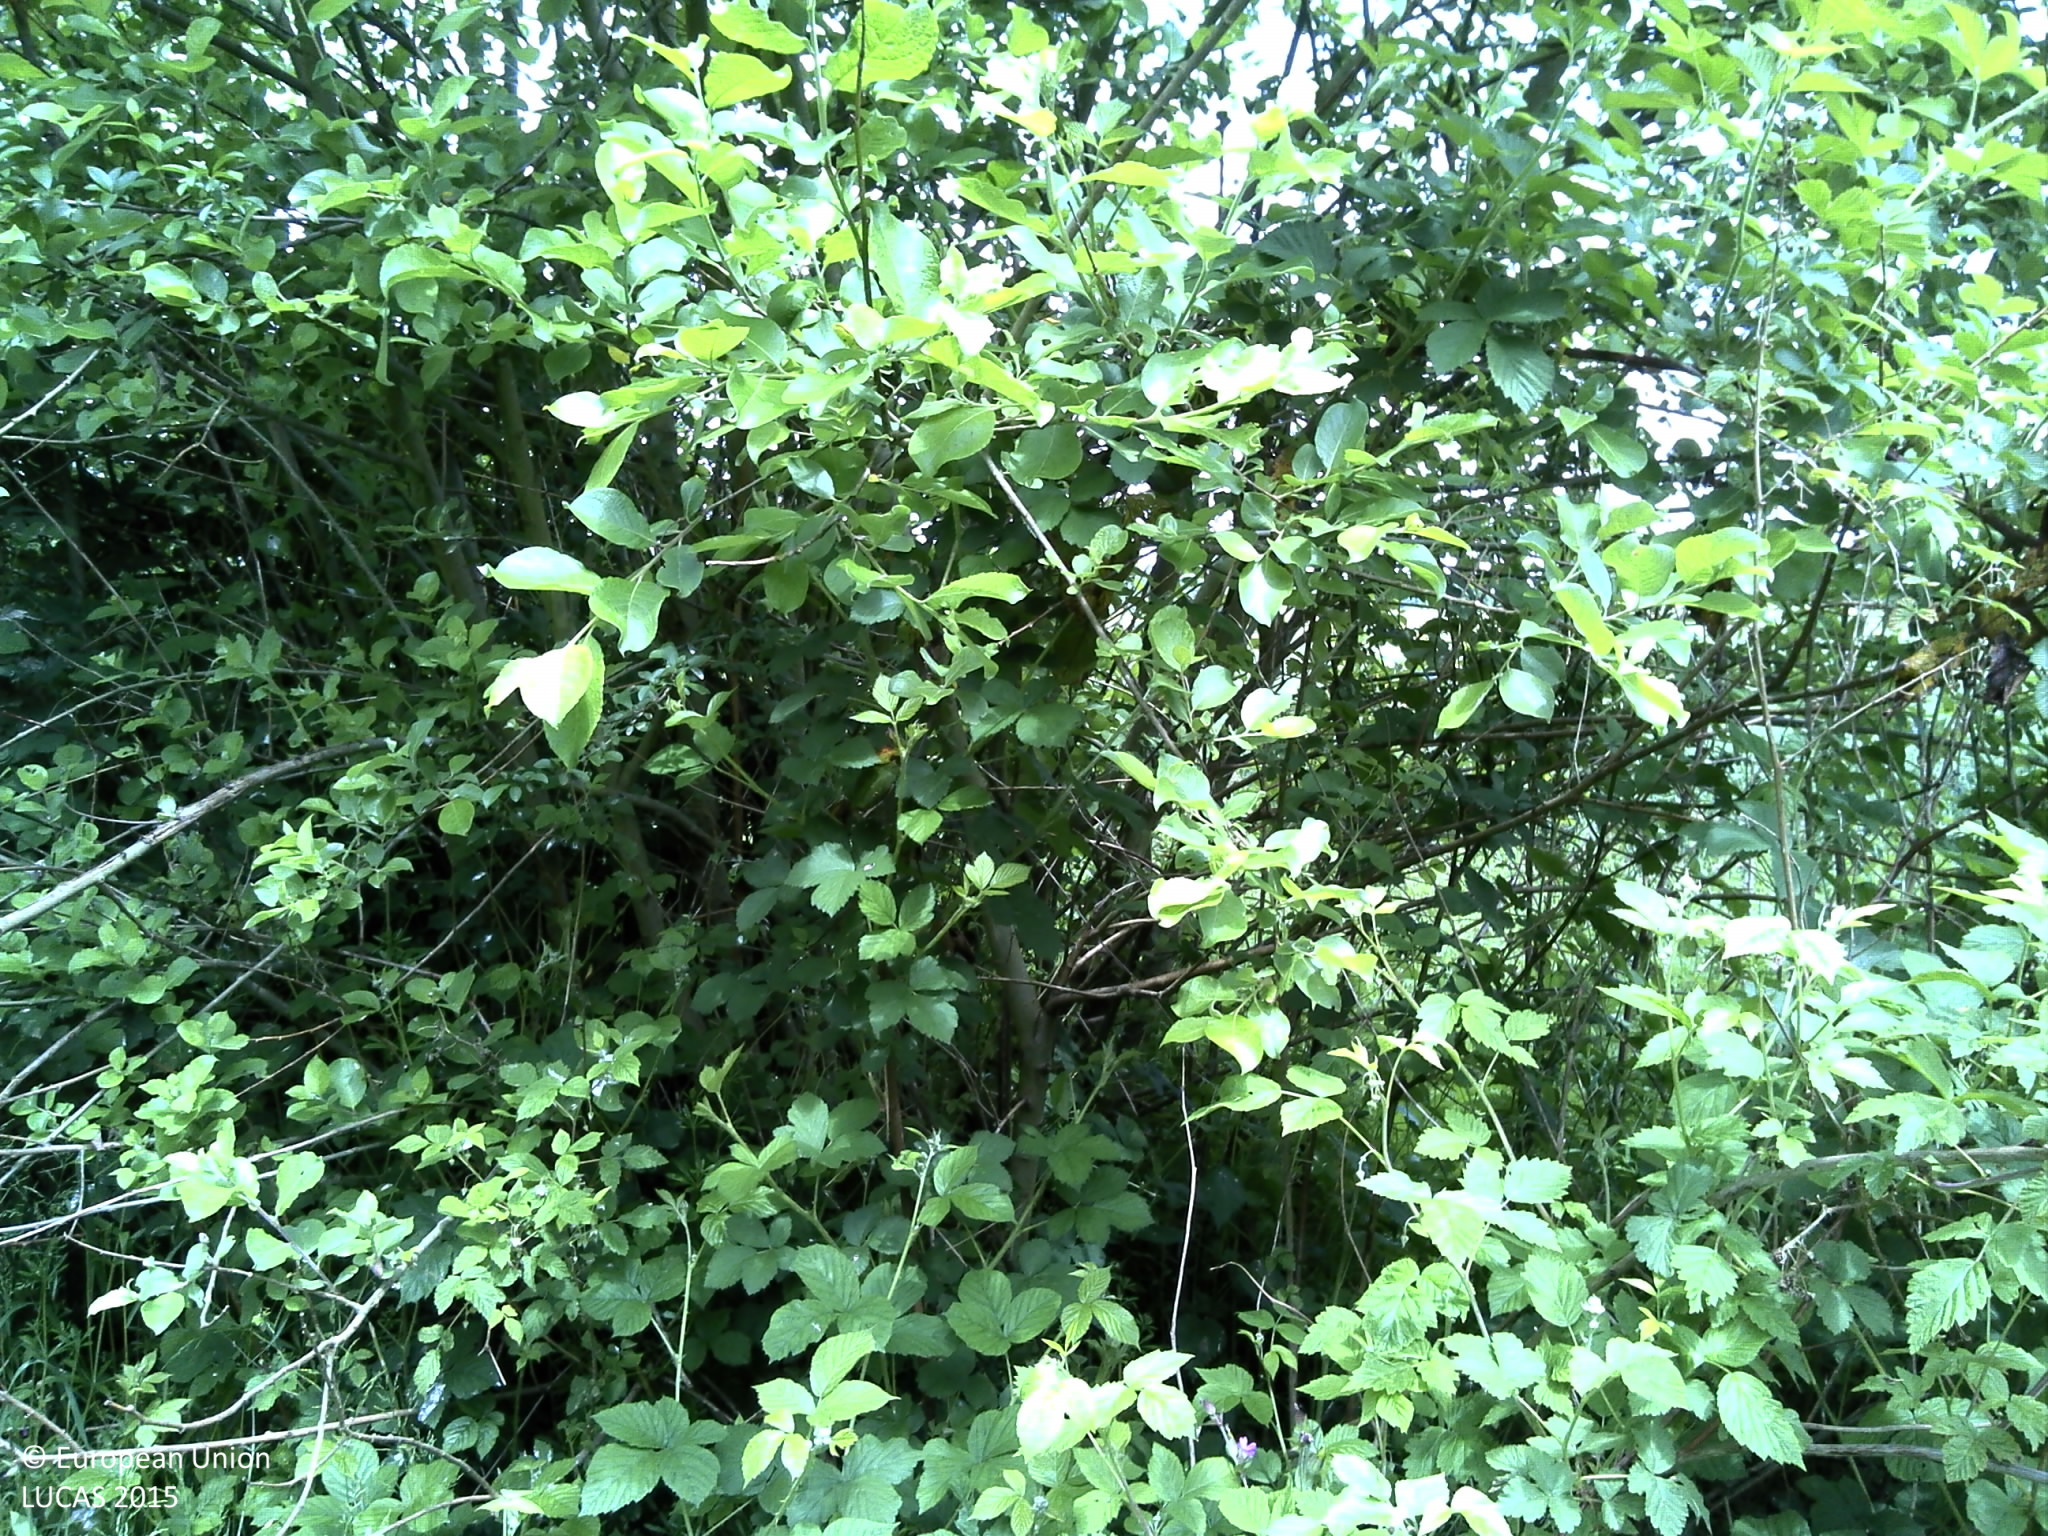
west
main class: Cropland
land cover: Rape and turnip rape
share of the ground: > 75 %
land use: Agriculture (excluding fallow land and kitchen gardens)
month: May
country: FR
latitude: 49.5541
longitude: 1.2015
